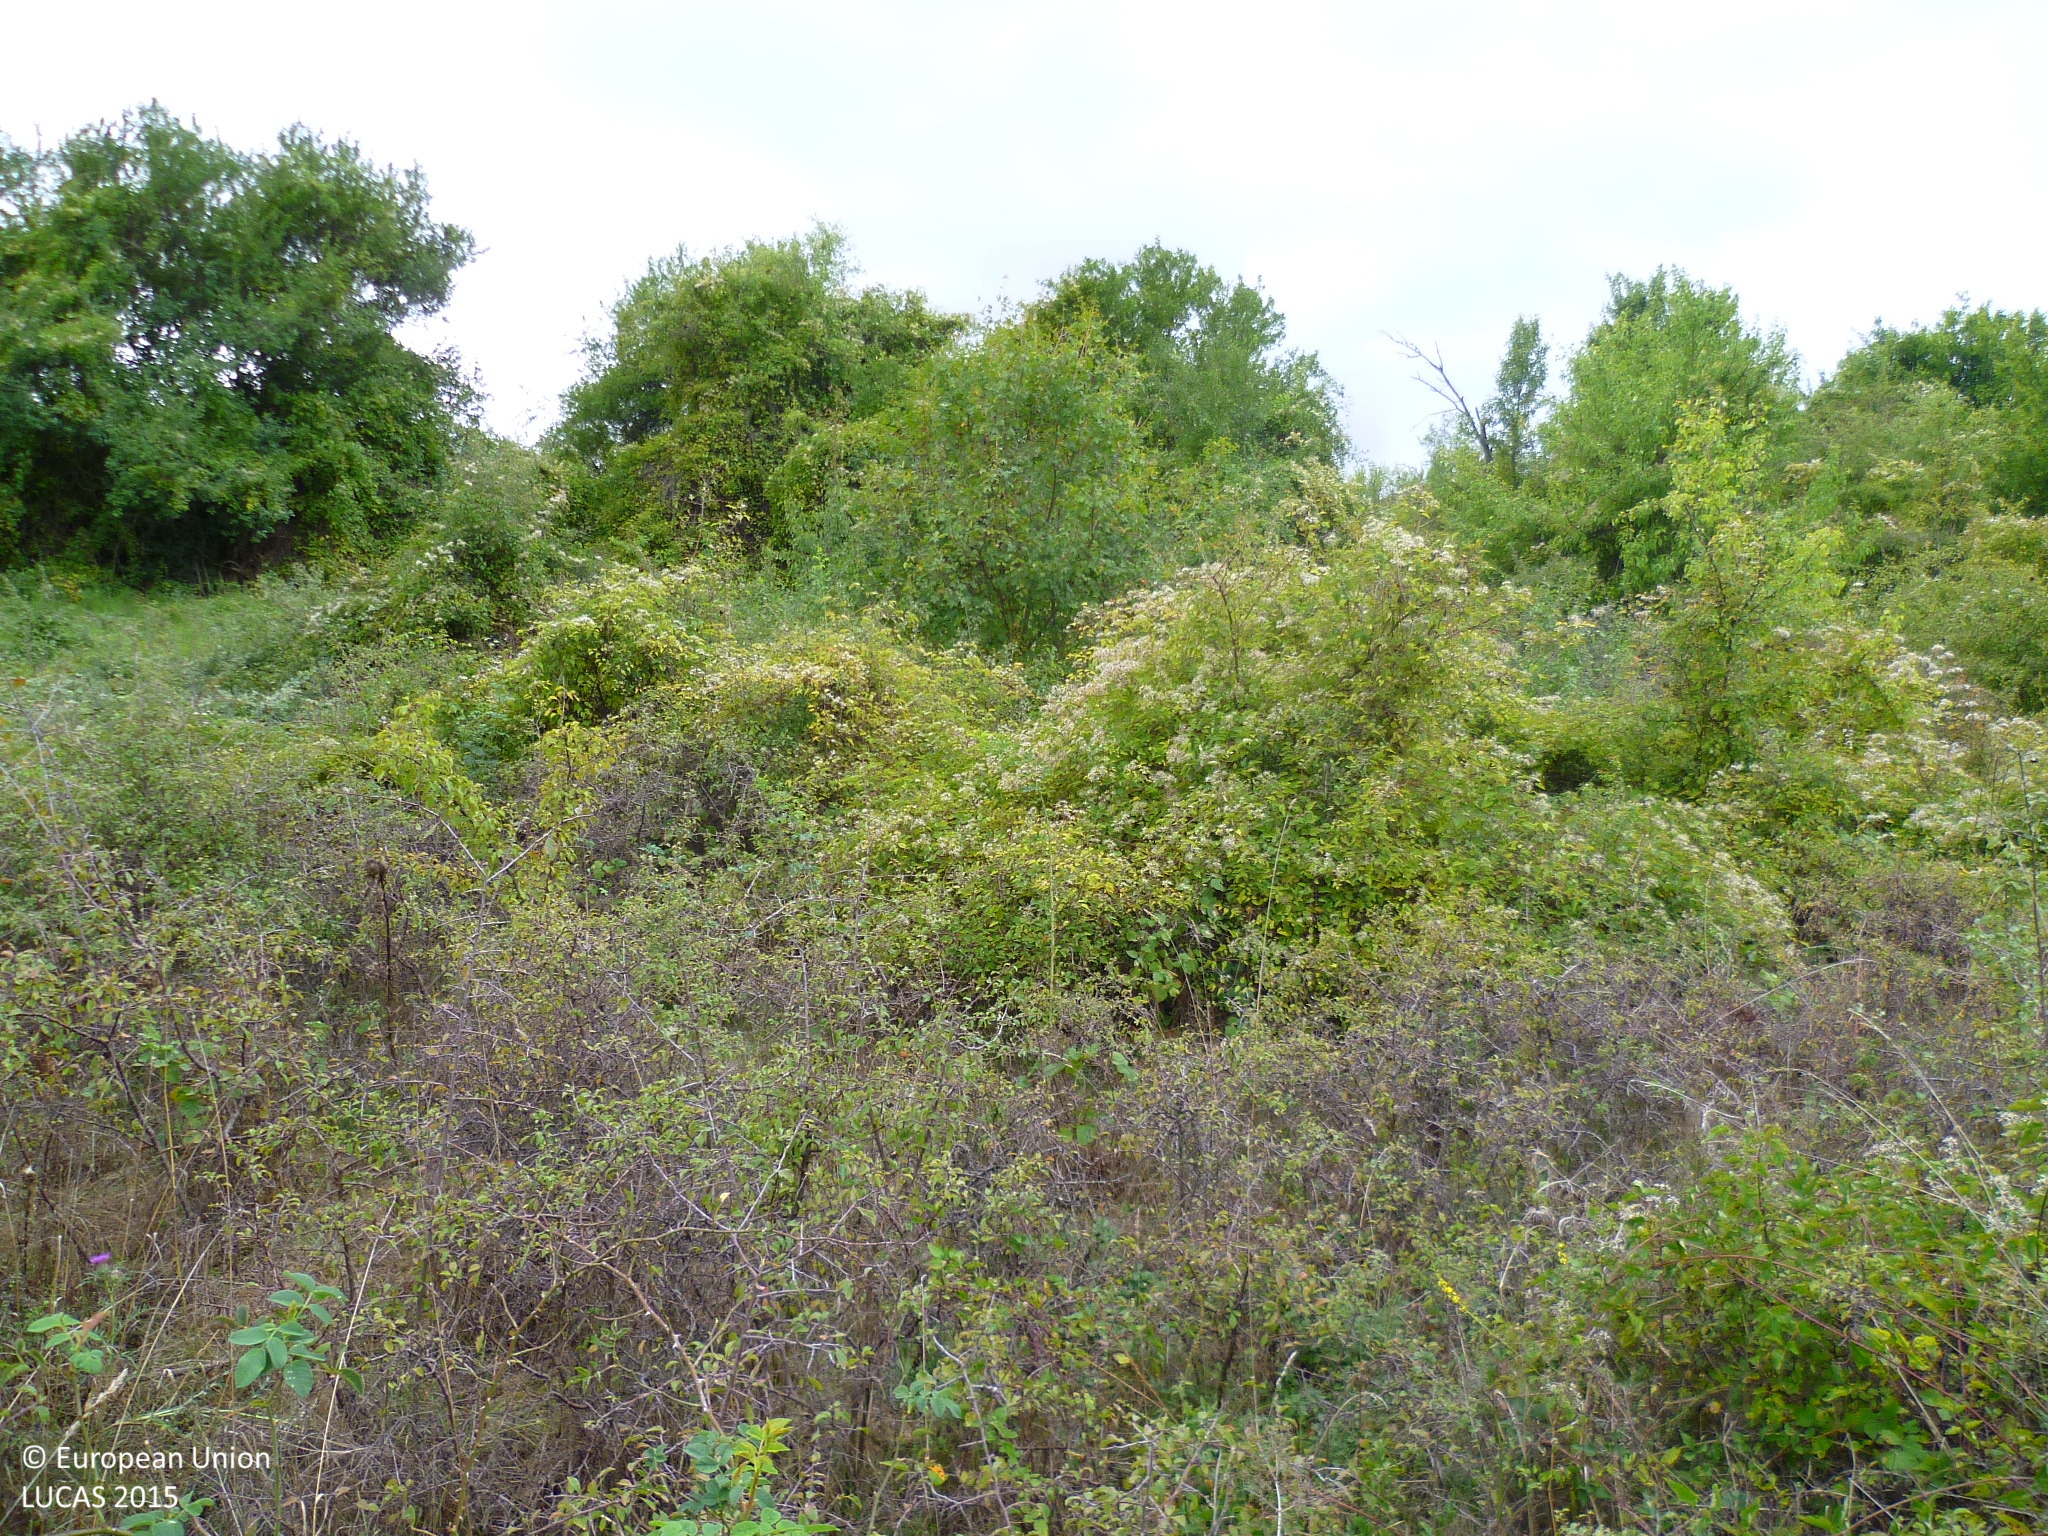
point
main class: Woodland
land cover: Broadleaved woodland
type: mesophytic deciduous forest
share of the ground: > 75 %
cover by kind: broadleaved forest trees 80 %, herbaceous plants 15 %, shrubs 5 %
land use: Semi-natural and natural areas not in use
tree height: > 5 m
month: September
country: BG
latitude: 42.6336
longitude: 22.7199
